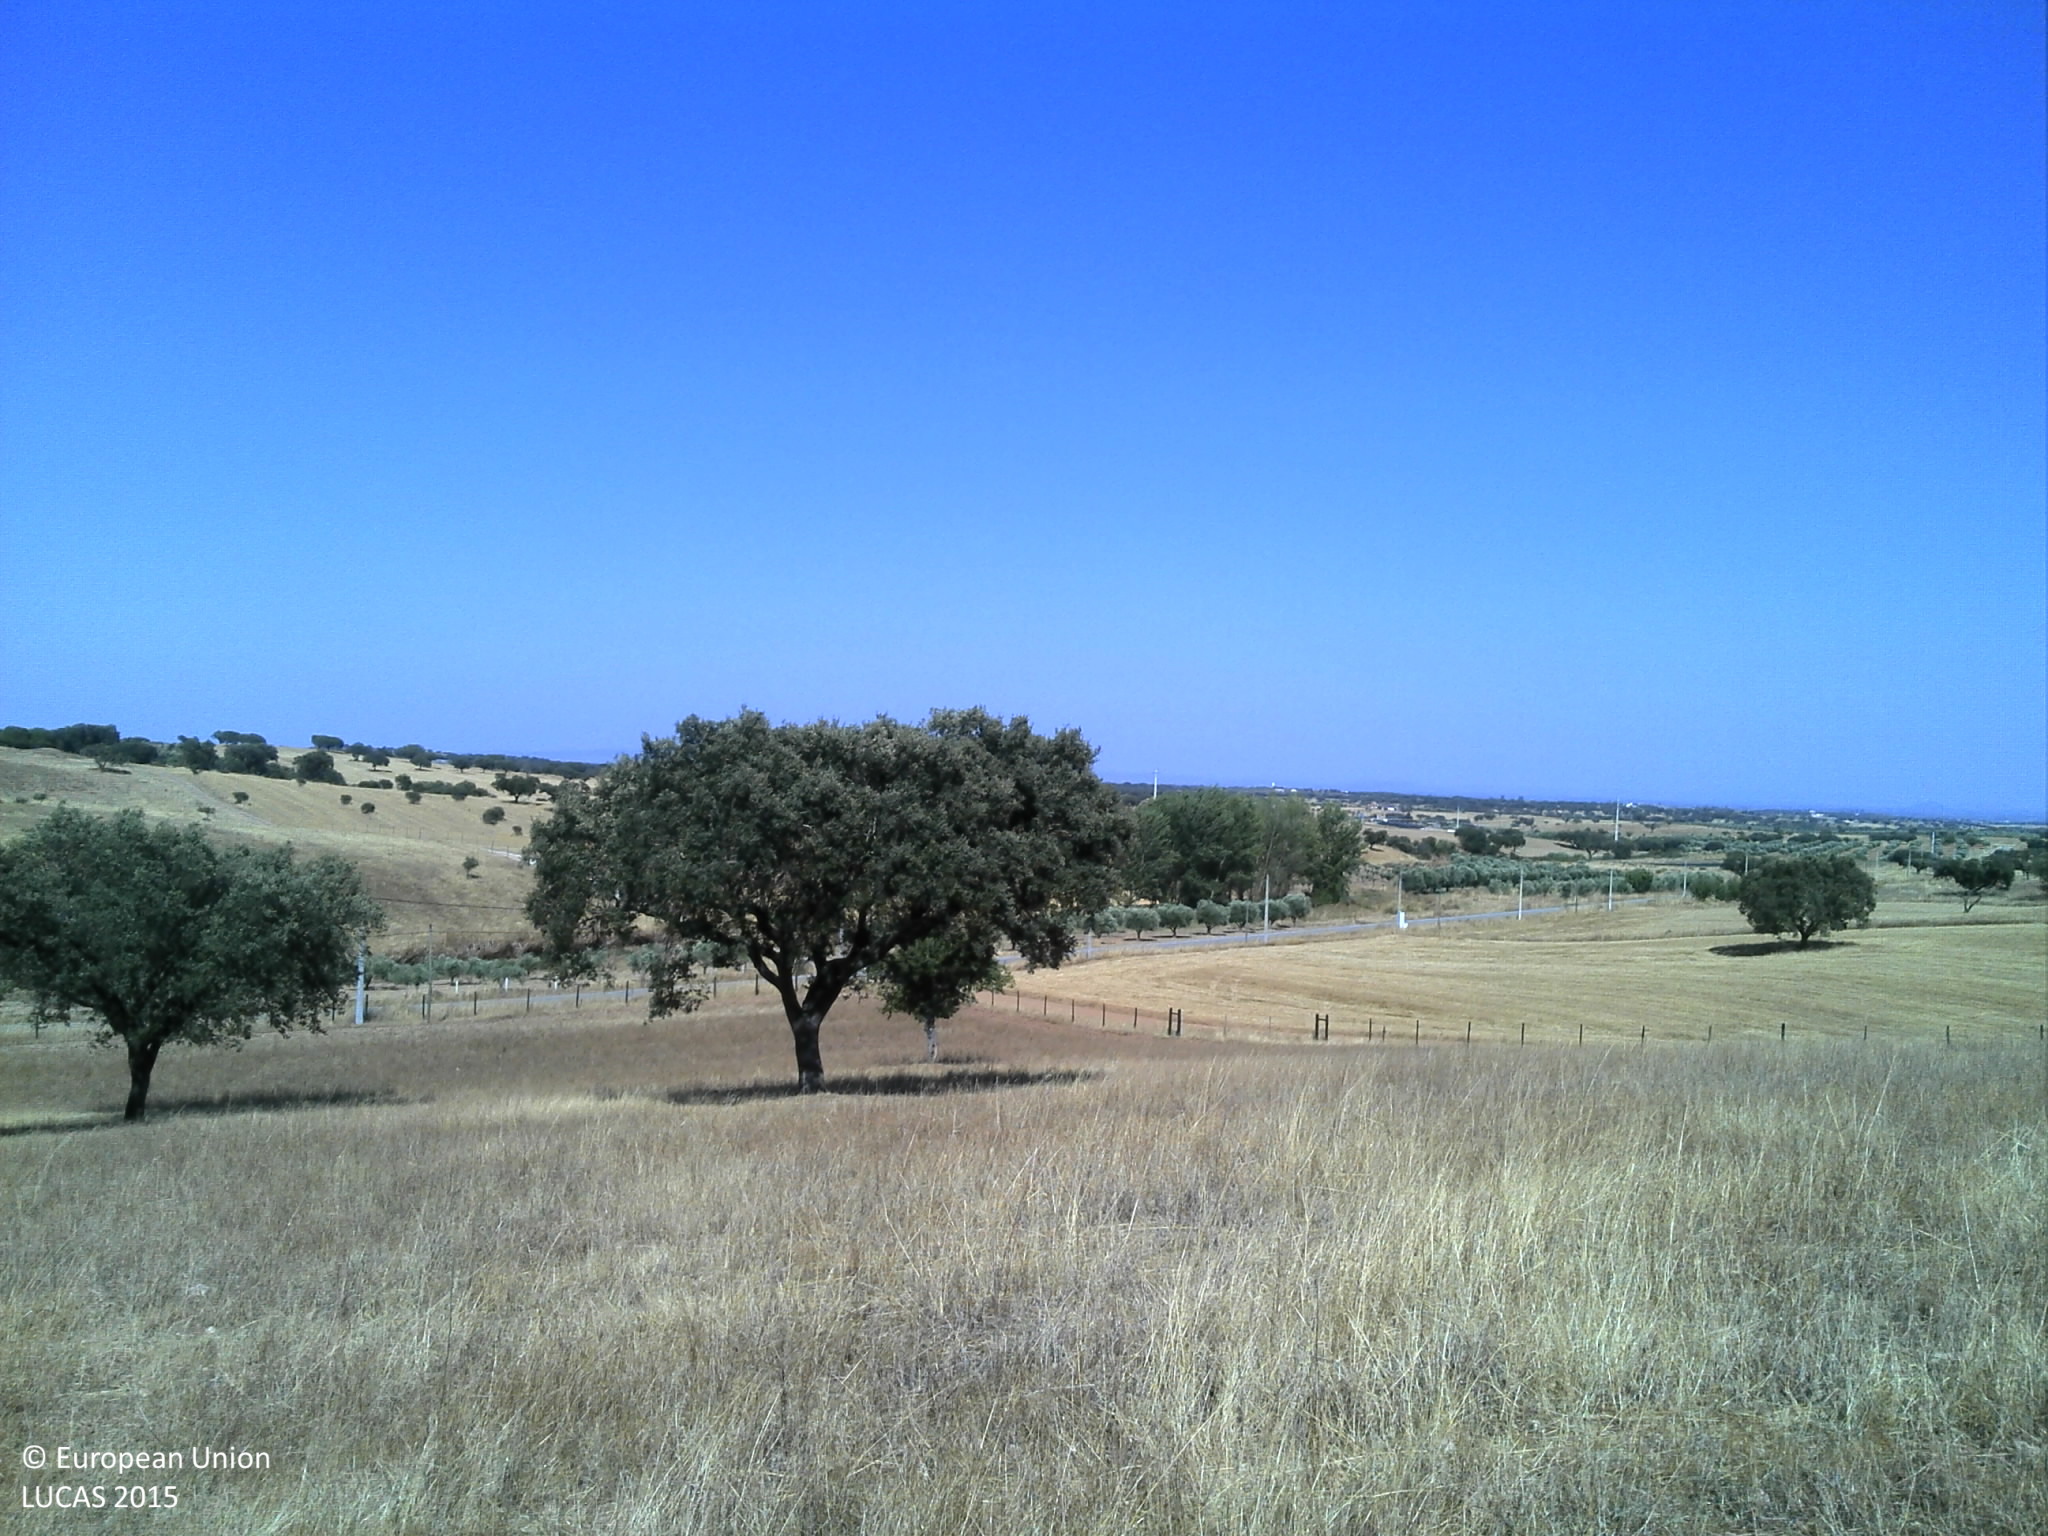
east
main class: Woodland
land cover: Broadleaved woodland
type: broadleaved evergreen forest
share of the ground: 10 - 25 %
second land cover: Grassland without tree/shrub cover
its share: 25 - 50 %
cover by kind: unconsolidated bare surface 50 %, herbaceous plants 30 %, broadleaved forest trees 20 %
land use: Forestry
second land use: Agriculture (excluding fallow land and kitchen gardens)
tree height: > 5 m
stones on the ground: < 10 %
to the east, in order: Broadleaved woodland; Grassland without tree/shrub cover; Broadleaved woodland; Grassland without tree/shrub cover; Fences; Grass margins; Tracks; Oats; Electric lines; Grass margins; Electric lines; Ditches and canals; Grass margins; Paved roads, cycling and walking lanes; Grass margins; Olive groves; Grassland without tree/shrub cover; Rivers and streams; Lines of trees
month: July
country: PT
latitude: 38.5410
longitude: -7.4556
